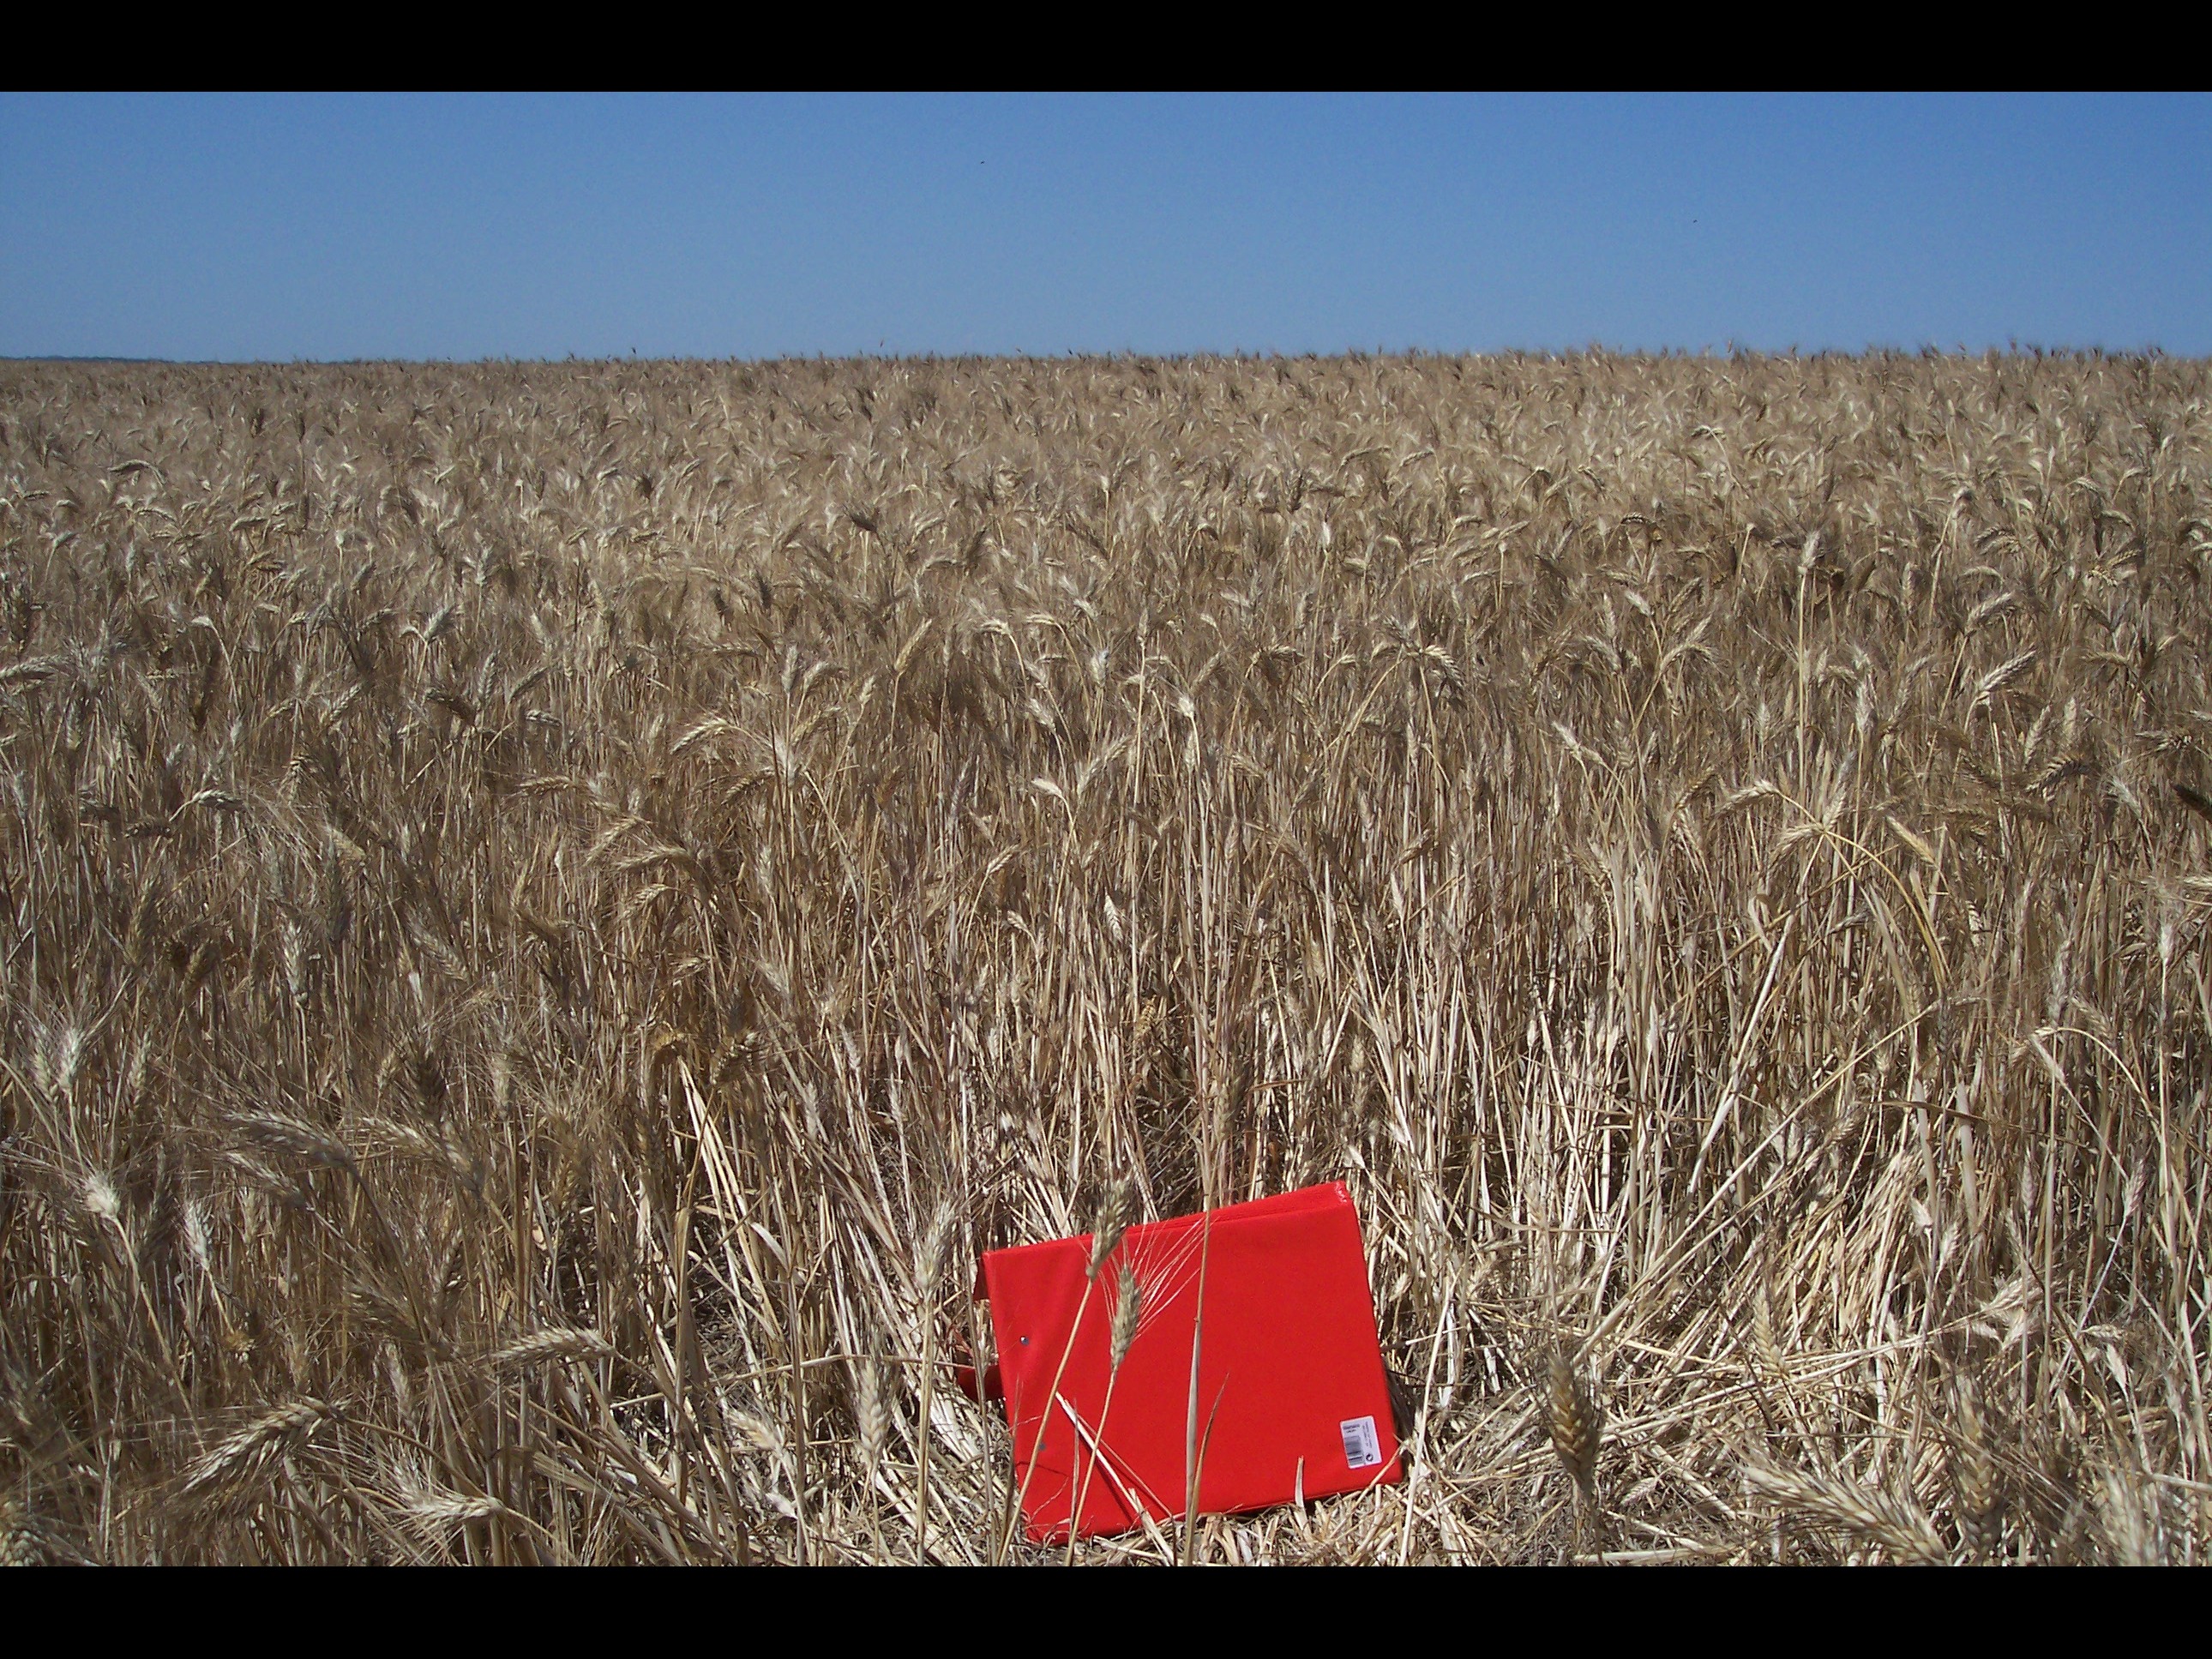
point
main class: Cropland
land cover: Durum wheat
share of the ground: > 75 %
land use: Agriculture (excluding fallow land and kitchen gardens)
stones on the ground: > 50 %
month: June
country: ES
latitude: 37.5150
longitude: -6.1739
